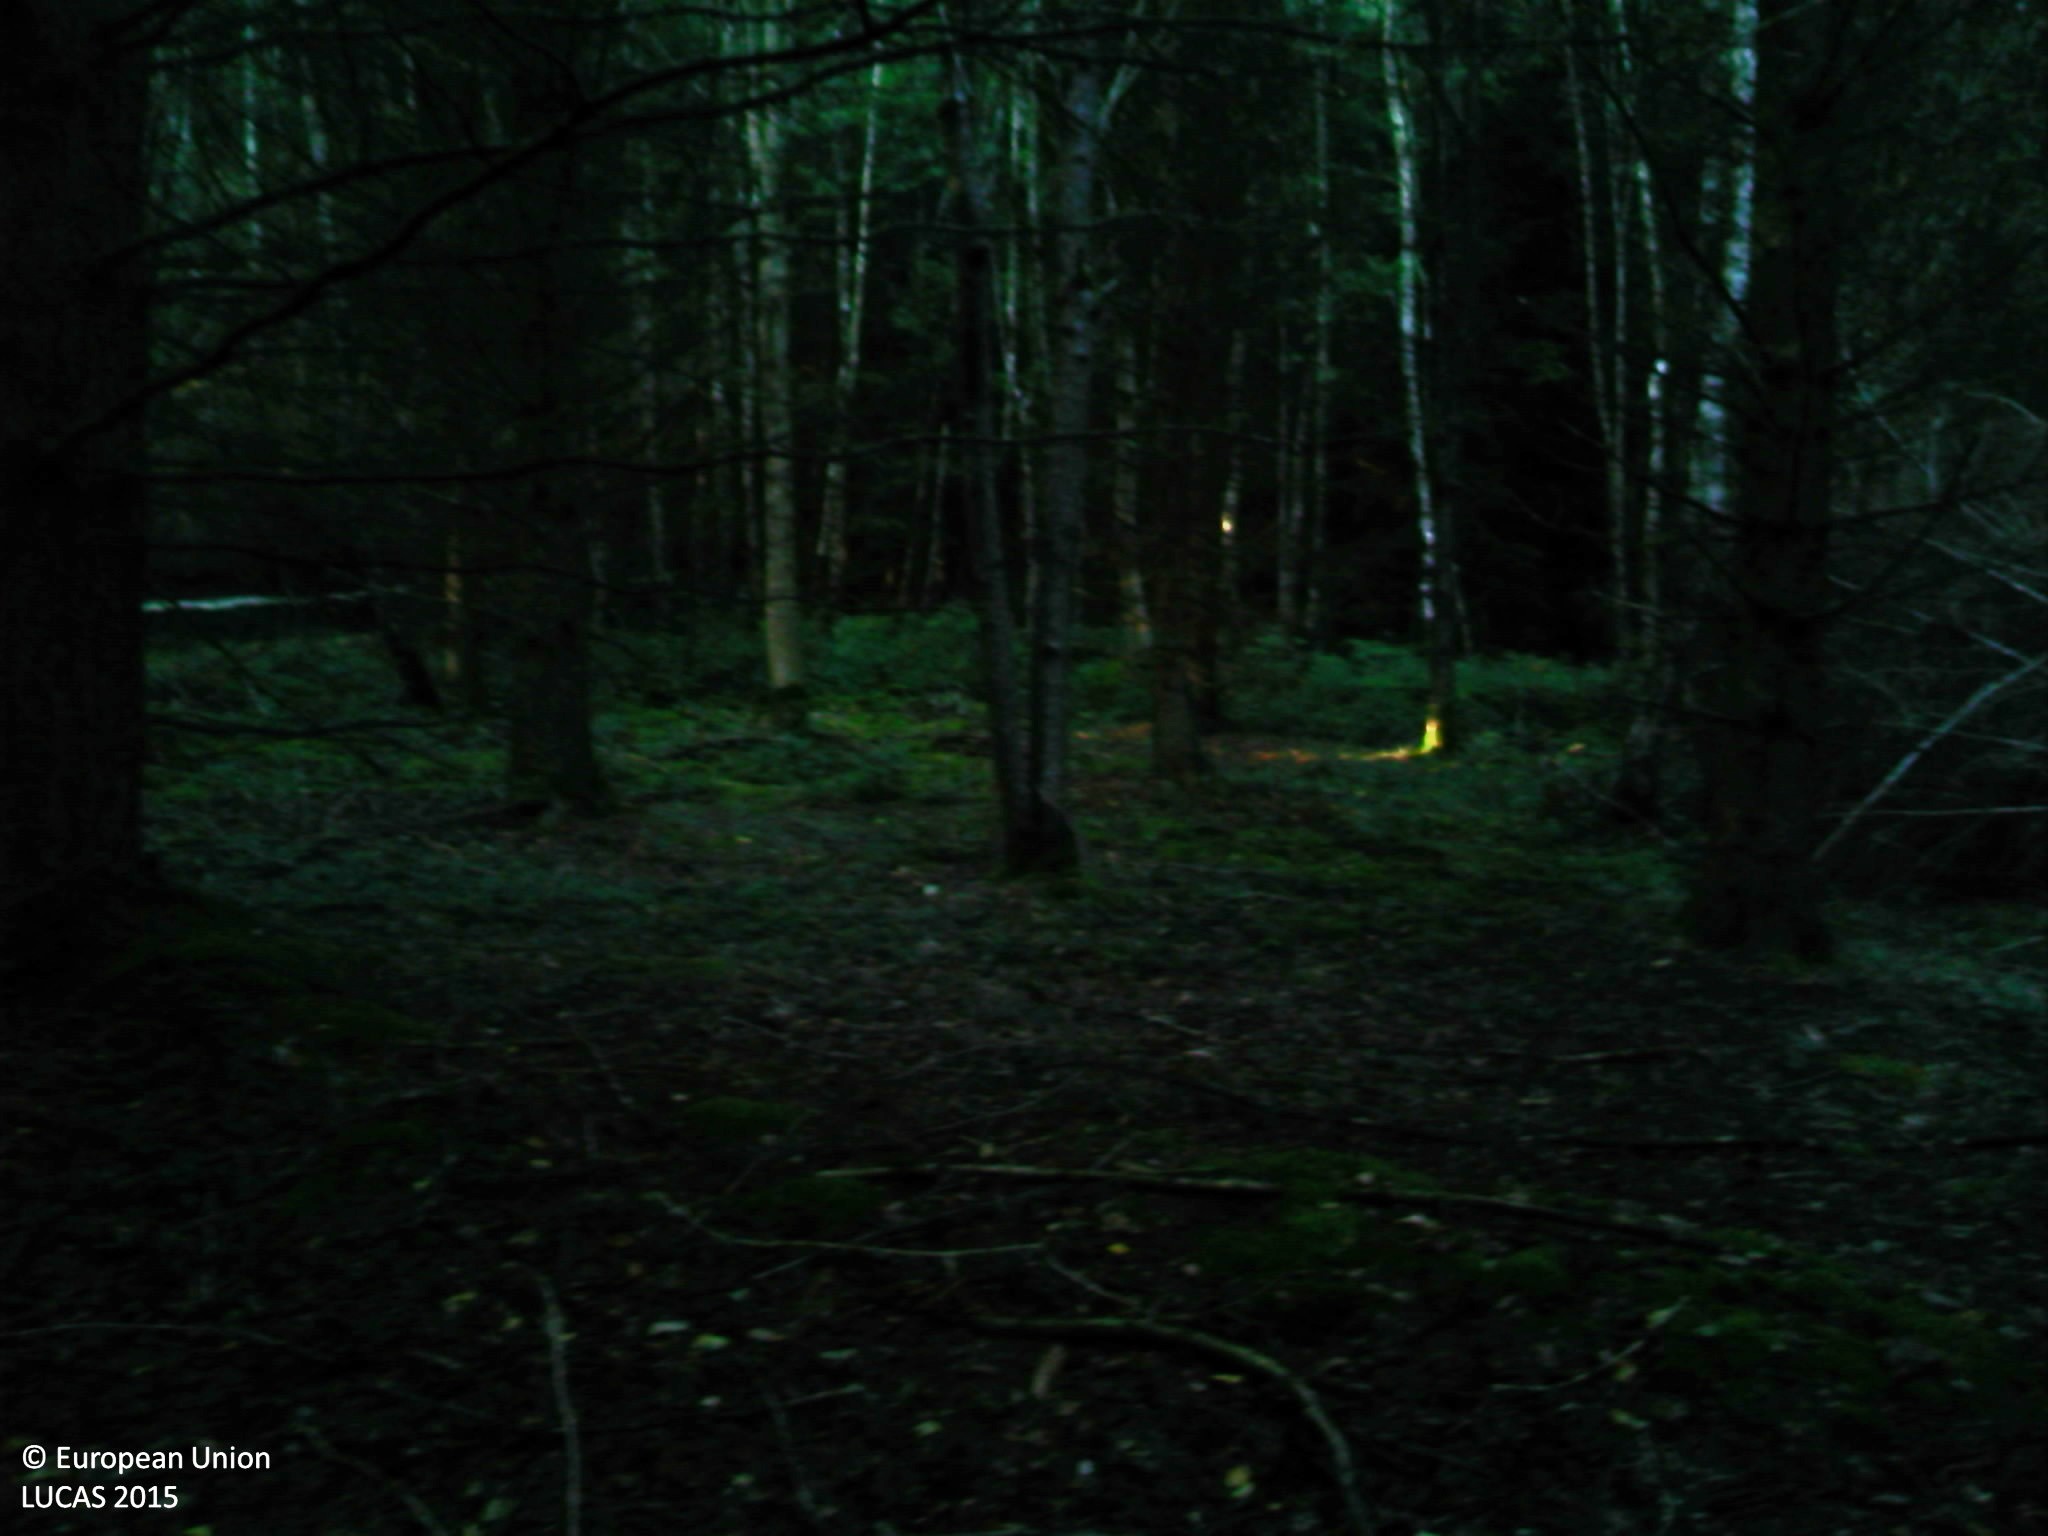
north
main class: Woodland
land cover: Spruce dominated mixed woodland
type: mesophytic deciduous forest
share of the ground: > 75 %
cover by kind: coniferous forest trees 45 %, broadleaved forest trees 25 %, shrubs 10 %, herbaceous plants 10 %, lichens and mosses 10 %
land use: Forestry
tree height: > 5 m
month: September
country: FR
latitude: 48.4714
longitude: 0.7936
